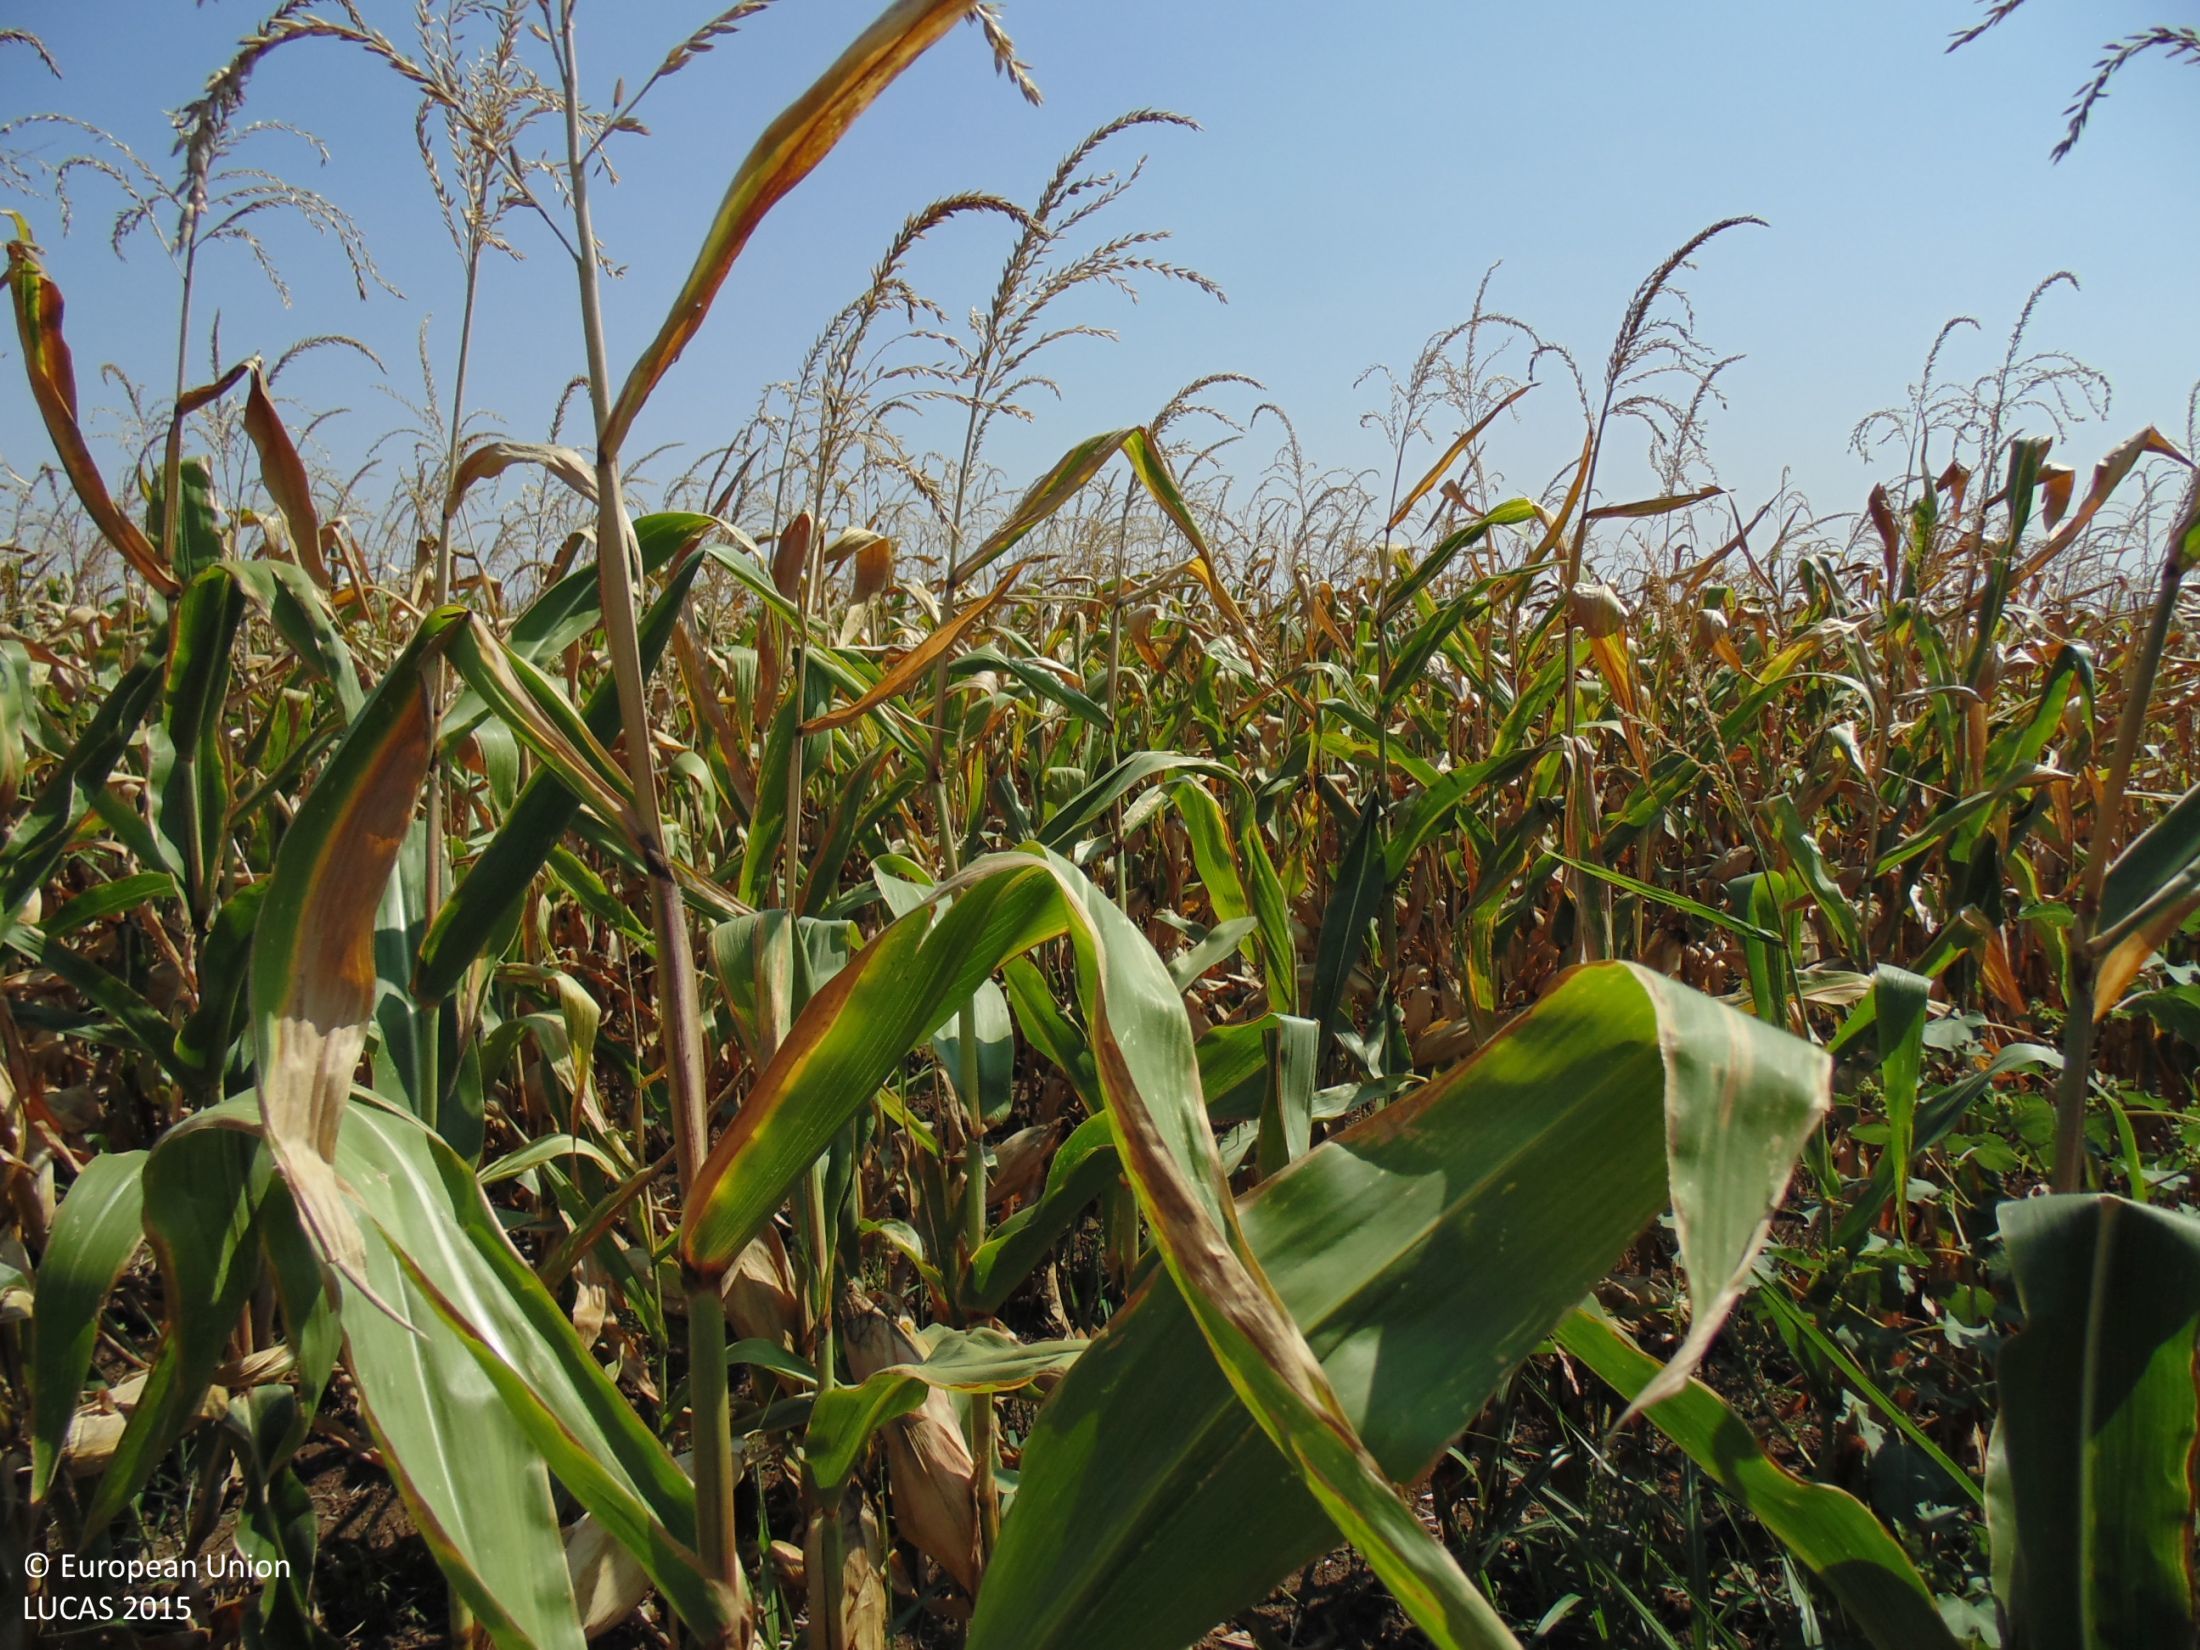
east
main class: Cropland
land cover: Maize
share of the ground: > 75 %
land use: Agriculture (excluding fallow land and kitchen gardens)
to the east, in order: Maize; Grass margins; Maize; Grass margins; Maize; Grass margins; Common wheat
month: August
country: BG
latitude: 43.6889
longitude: 27.4383
